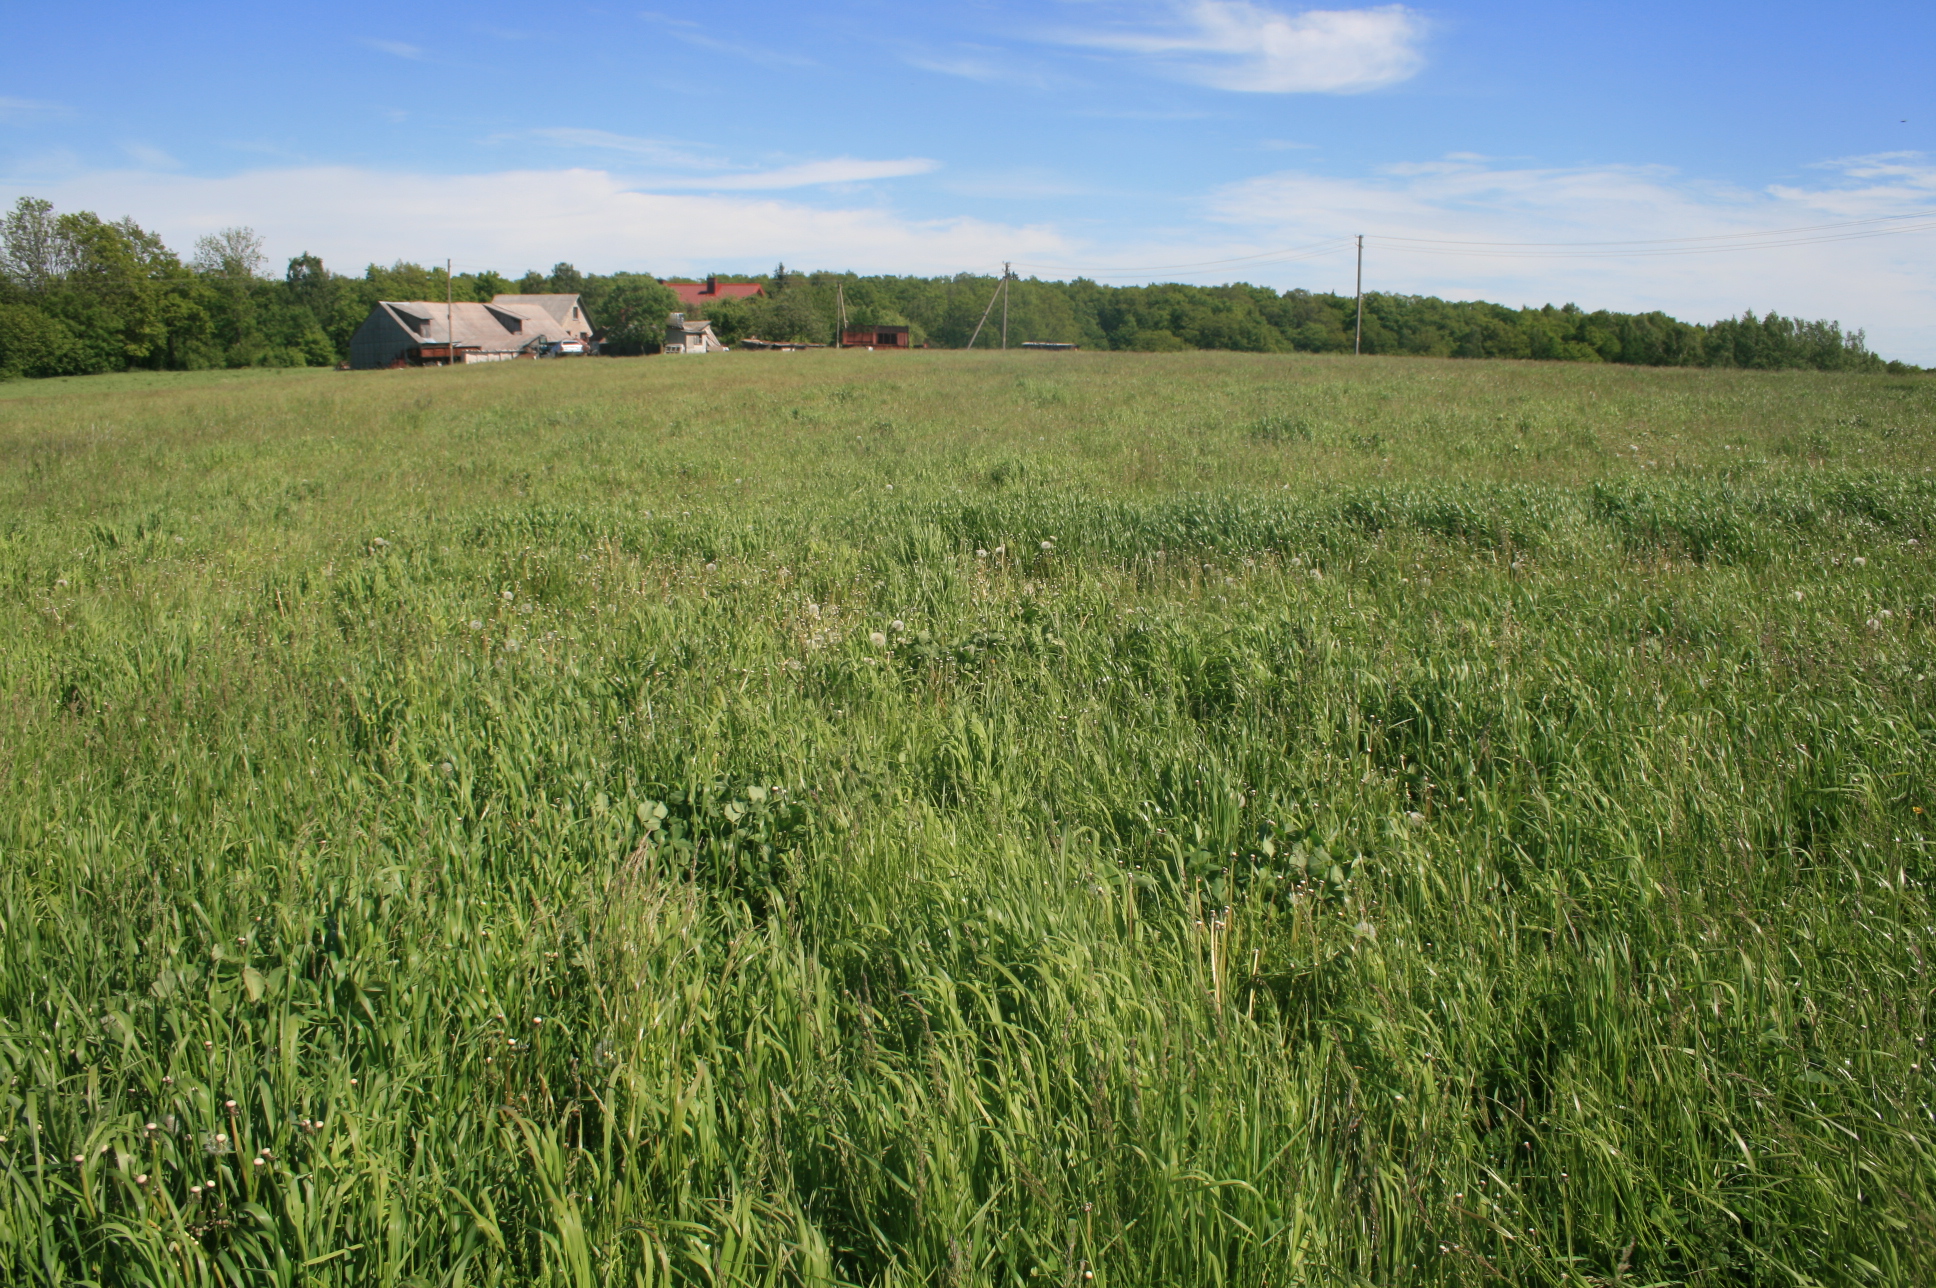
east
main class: Grassland
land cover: Grassland without tree/shrub cover
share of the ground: > 75 %
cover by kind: herbaceous plants 100 %
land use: Agriculture (excluding fallow land and kitchen gardens)
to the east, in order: Grassland without tree/shrub cover; Electric lines; Grassland without tree/shrub cover; Artificial constructions in urban areas; Grassland without tree/shrub cover; Common wheat; Grassland without tree/shrub cover
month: June
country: LT
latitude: 55.9125
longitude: 21.4183
